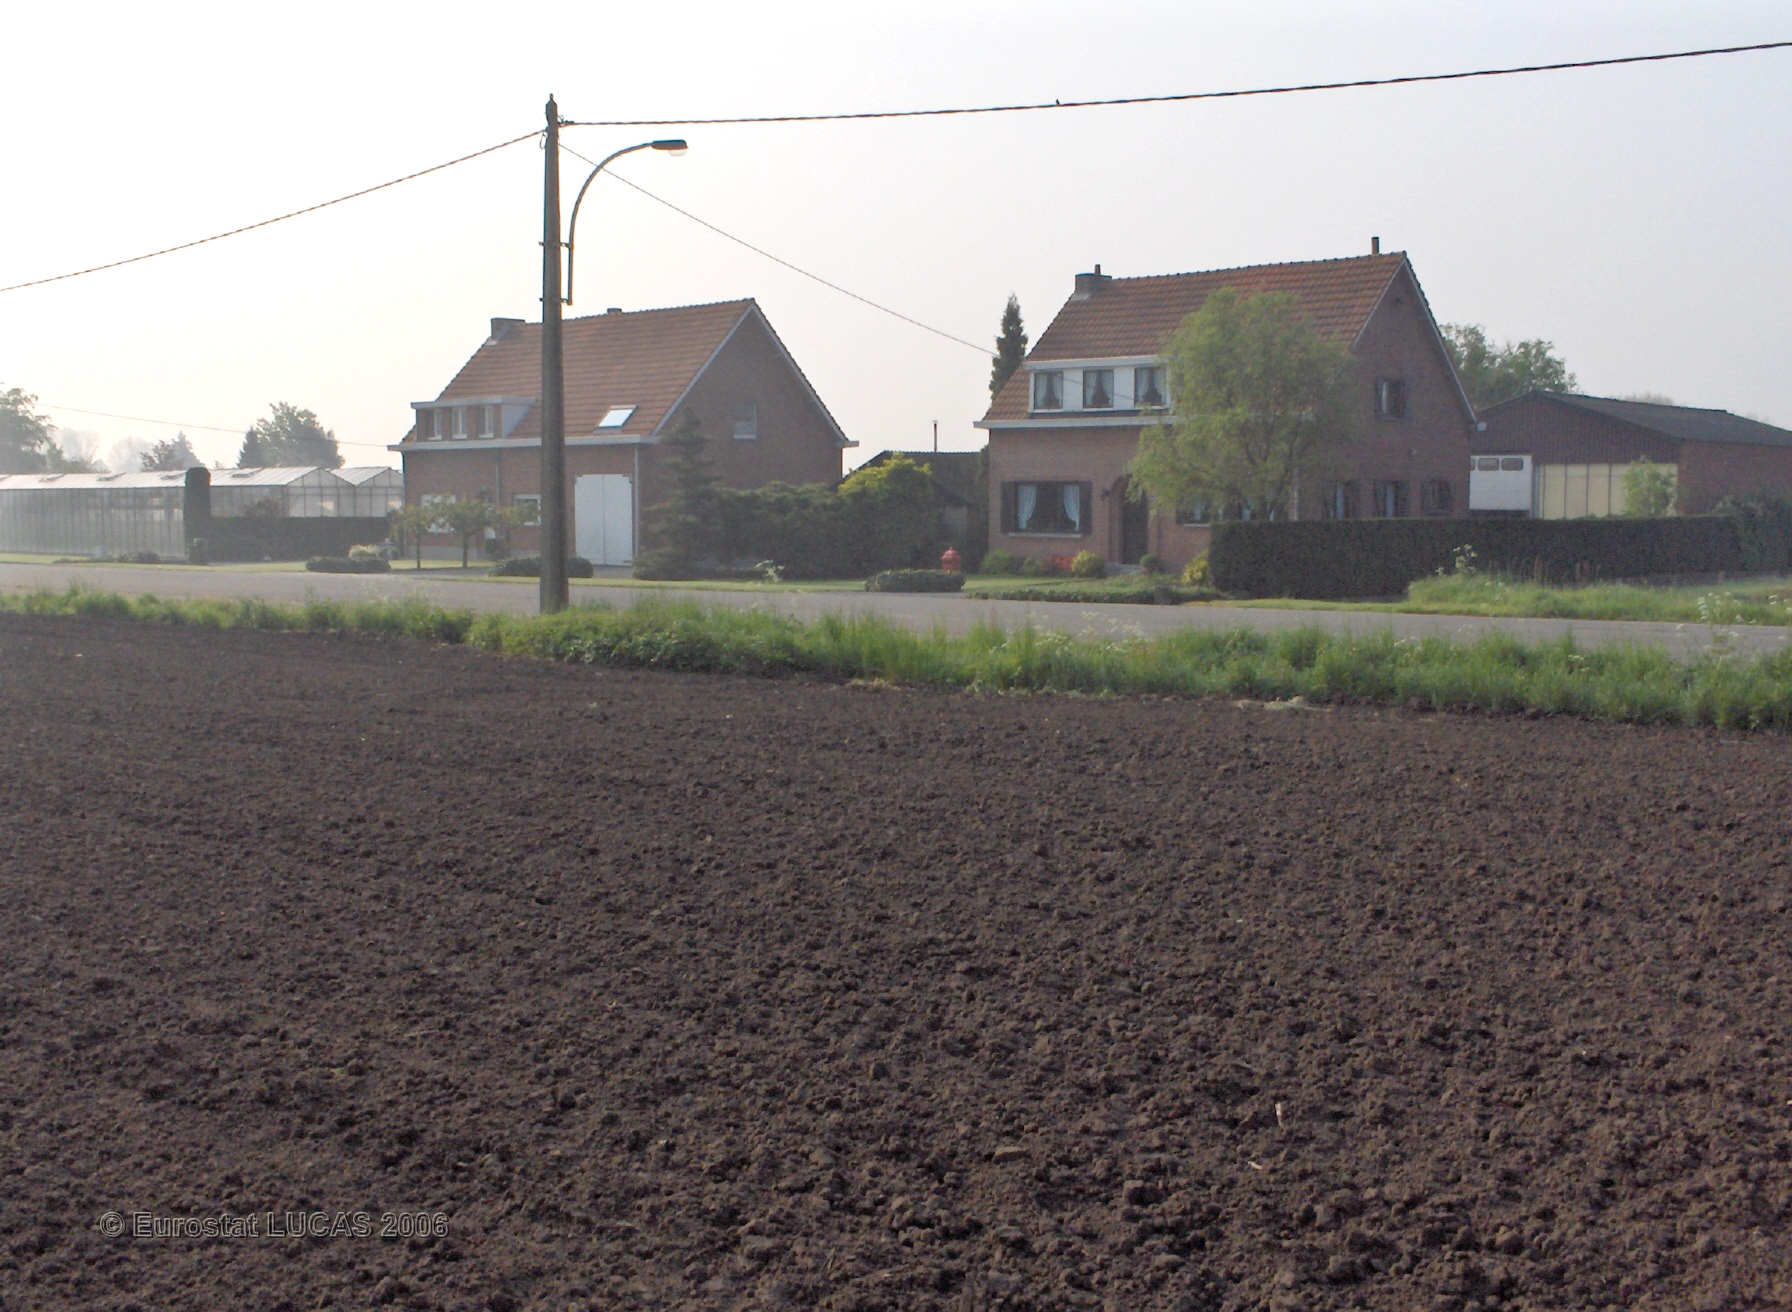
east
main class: Cropland
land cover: Maize
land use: Agriculture (excluding fallow land and kitchen gardens)
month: May
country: BE
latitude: 51.0940
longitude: 4.4412
